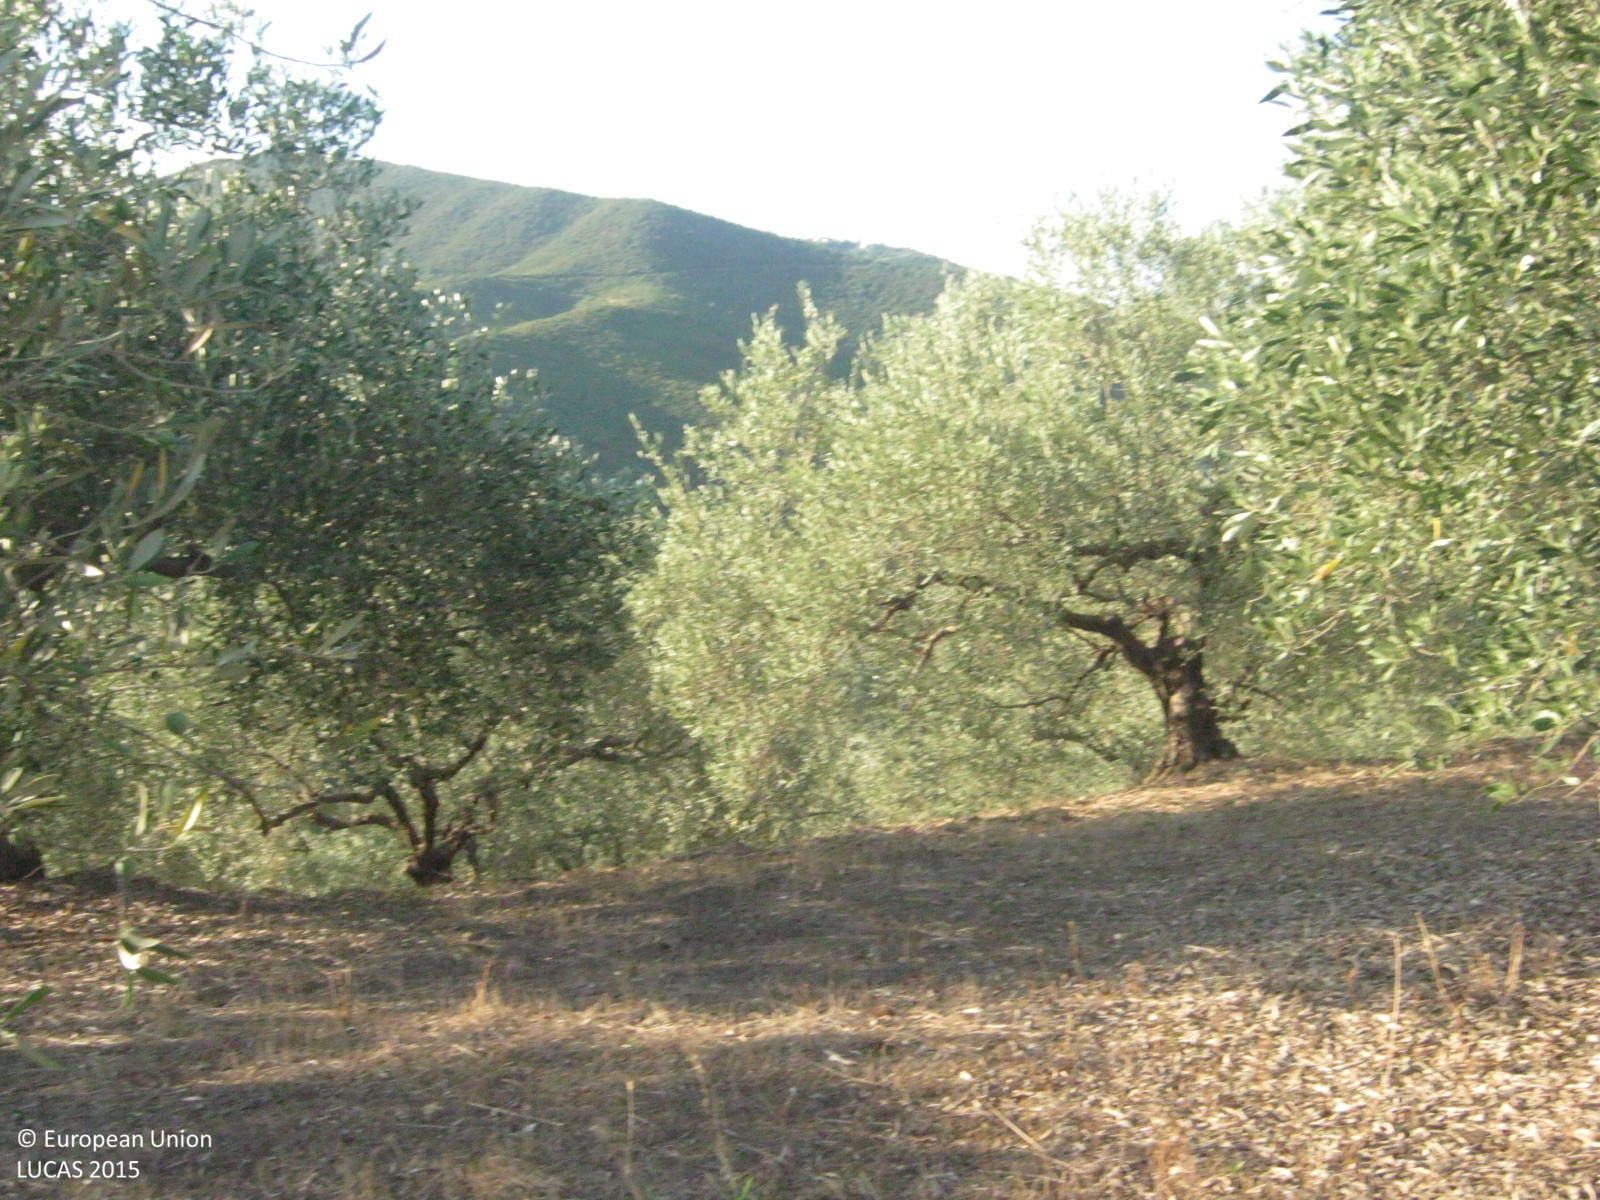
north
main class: Shrubland
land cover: Shrubland with sparse tree cover
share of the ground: > 75 %
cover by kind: shrubs 85 %, broadleaved forest trees 5 %, herbaceous plants 5 %, unconsolidated bare surface 5 %
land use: Semi-natural and natural areas not in use
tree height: < 5 m
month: August
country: GR
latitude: 39.1049
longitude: 21.1098
